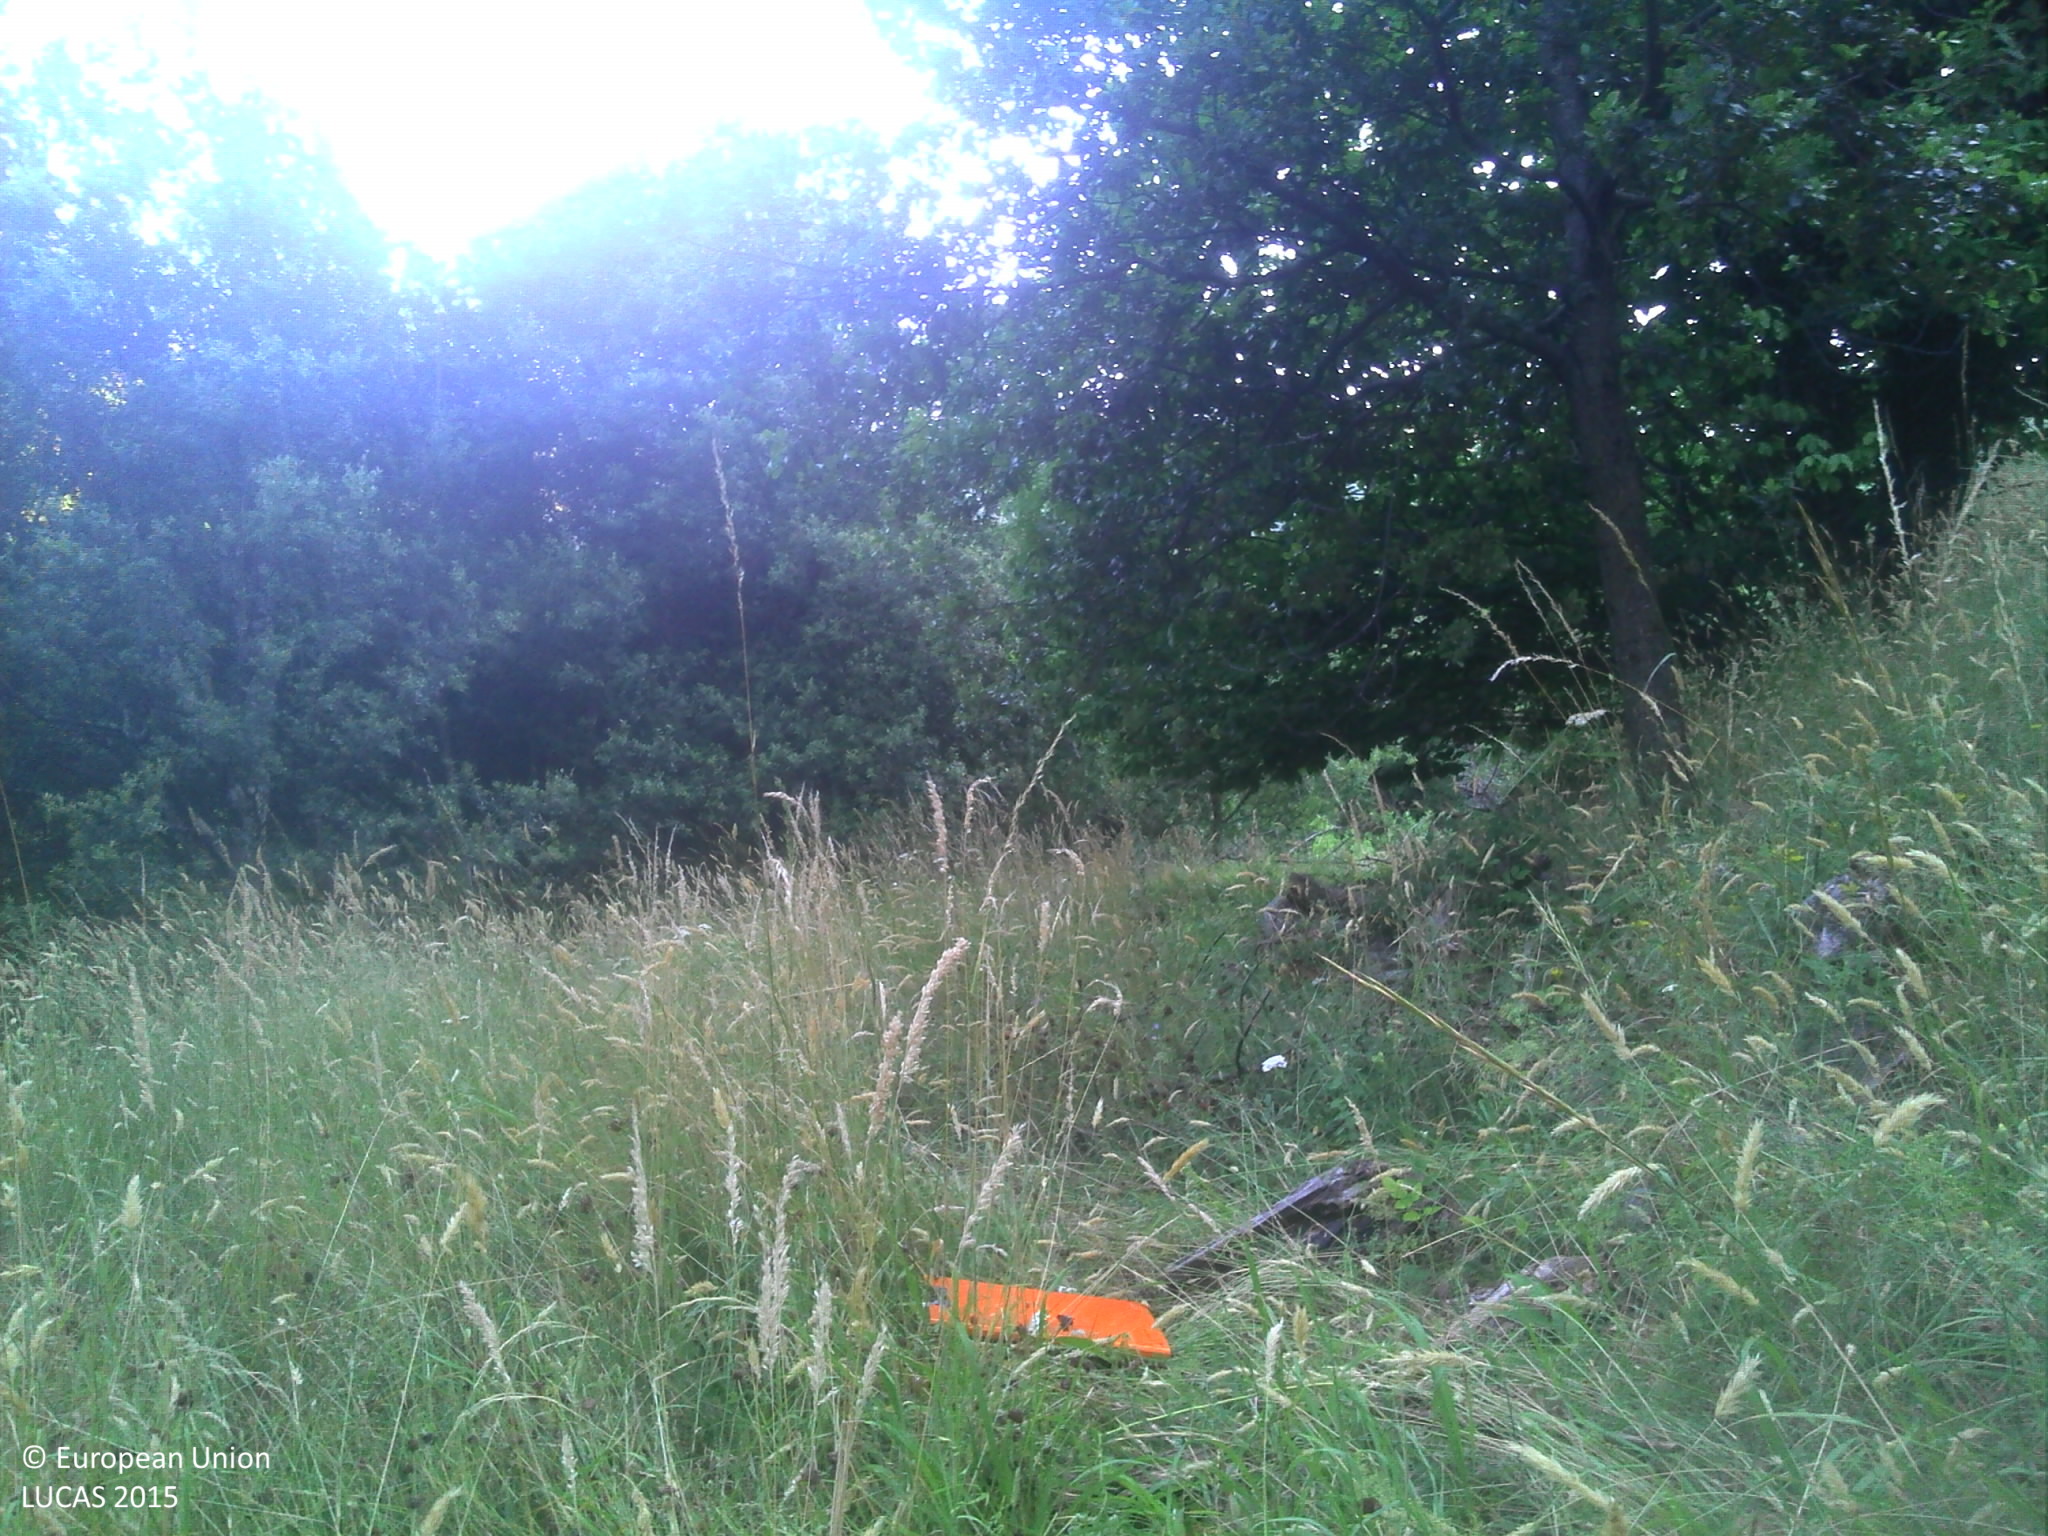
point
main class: Woodland
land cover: Broadleaved woodland
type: mesophytic deciduous forest
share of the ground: > 75 %
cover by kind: herbaceous plants 80 %, broadleaved forest trees 15 %, shrubs 5 %
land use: Forestry
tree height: > 5 m
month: June
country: FR
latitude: 44.3173
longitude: 3.9258
